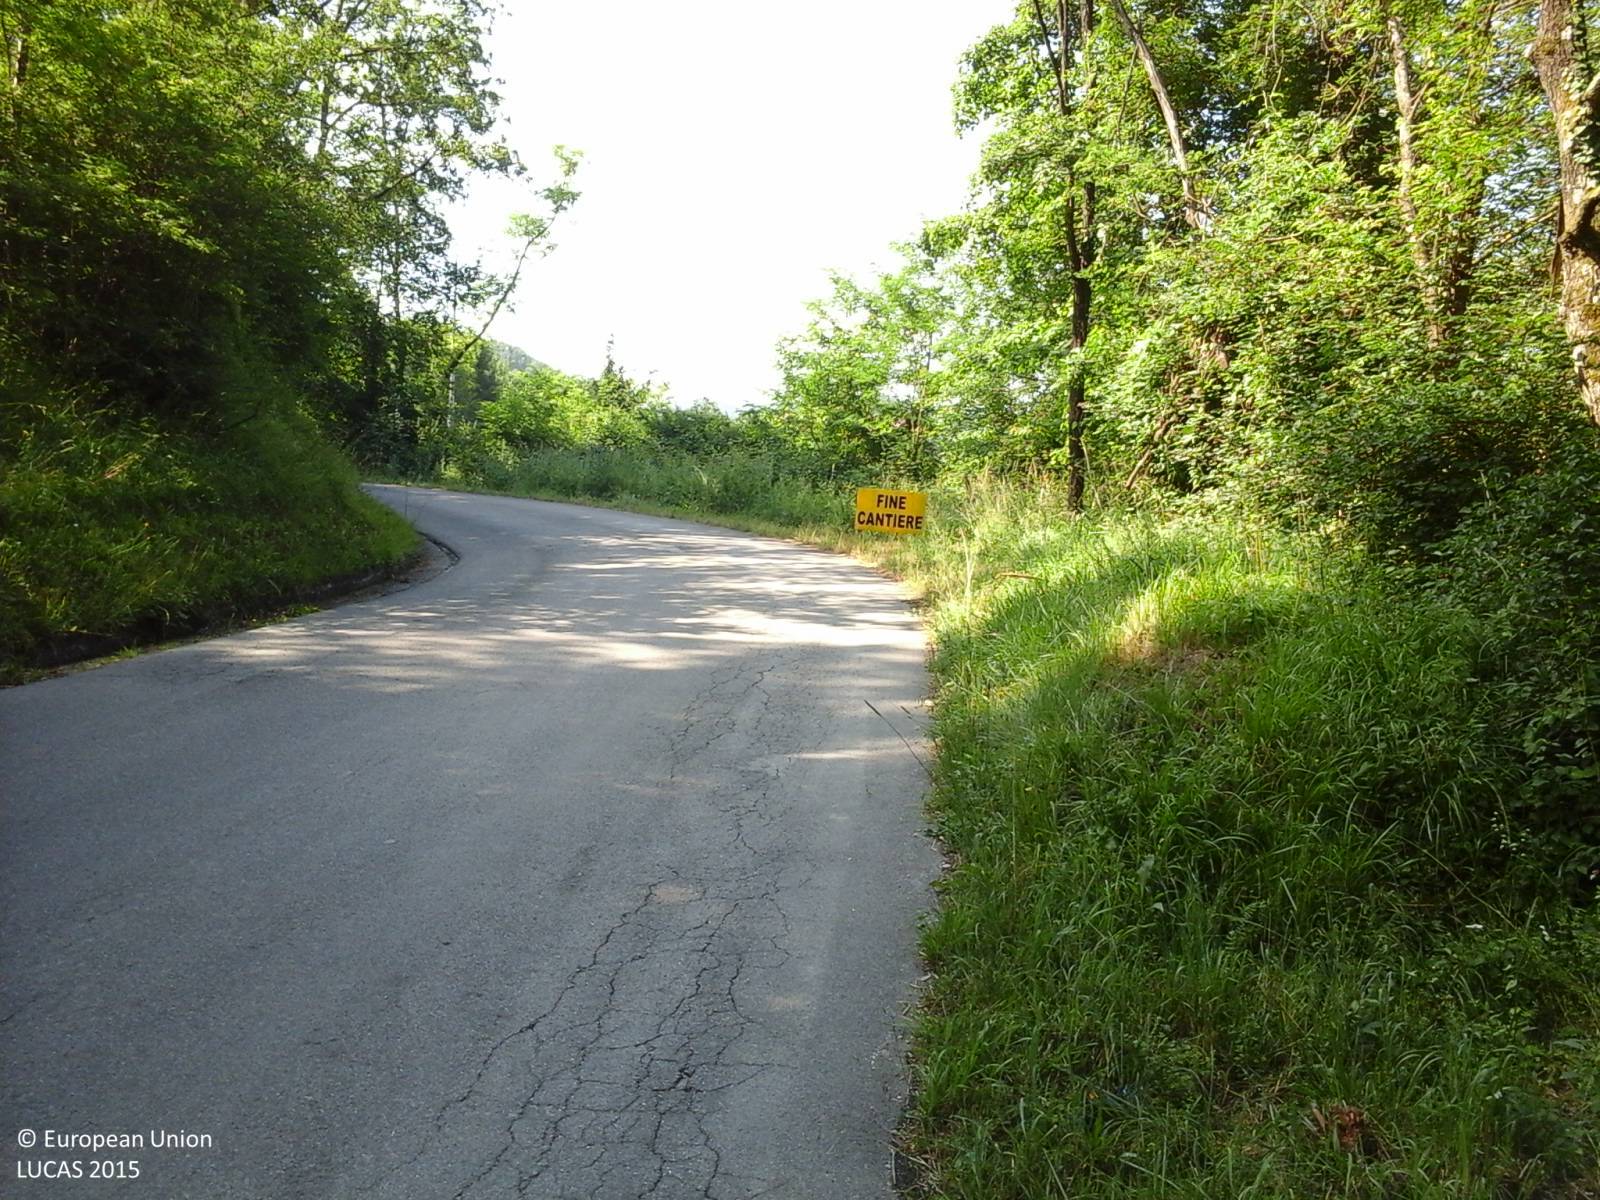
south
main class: Woodland
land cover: Broadleaved woodland
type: thermophilous deciduous forest
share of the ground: > 75 %
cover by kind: broadleaved forest trees 70 %, shrubs 30 %
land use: Forestry
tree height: < 5 m
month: June
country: IT
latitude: 44.0241
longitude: 10.6098
